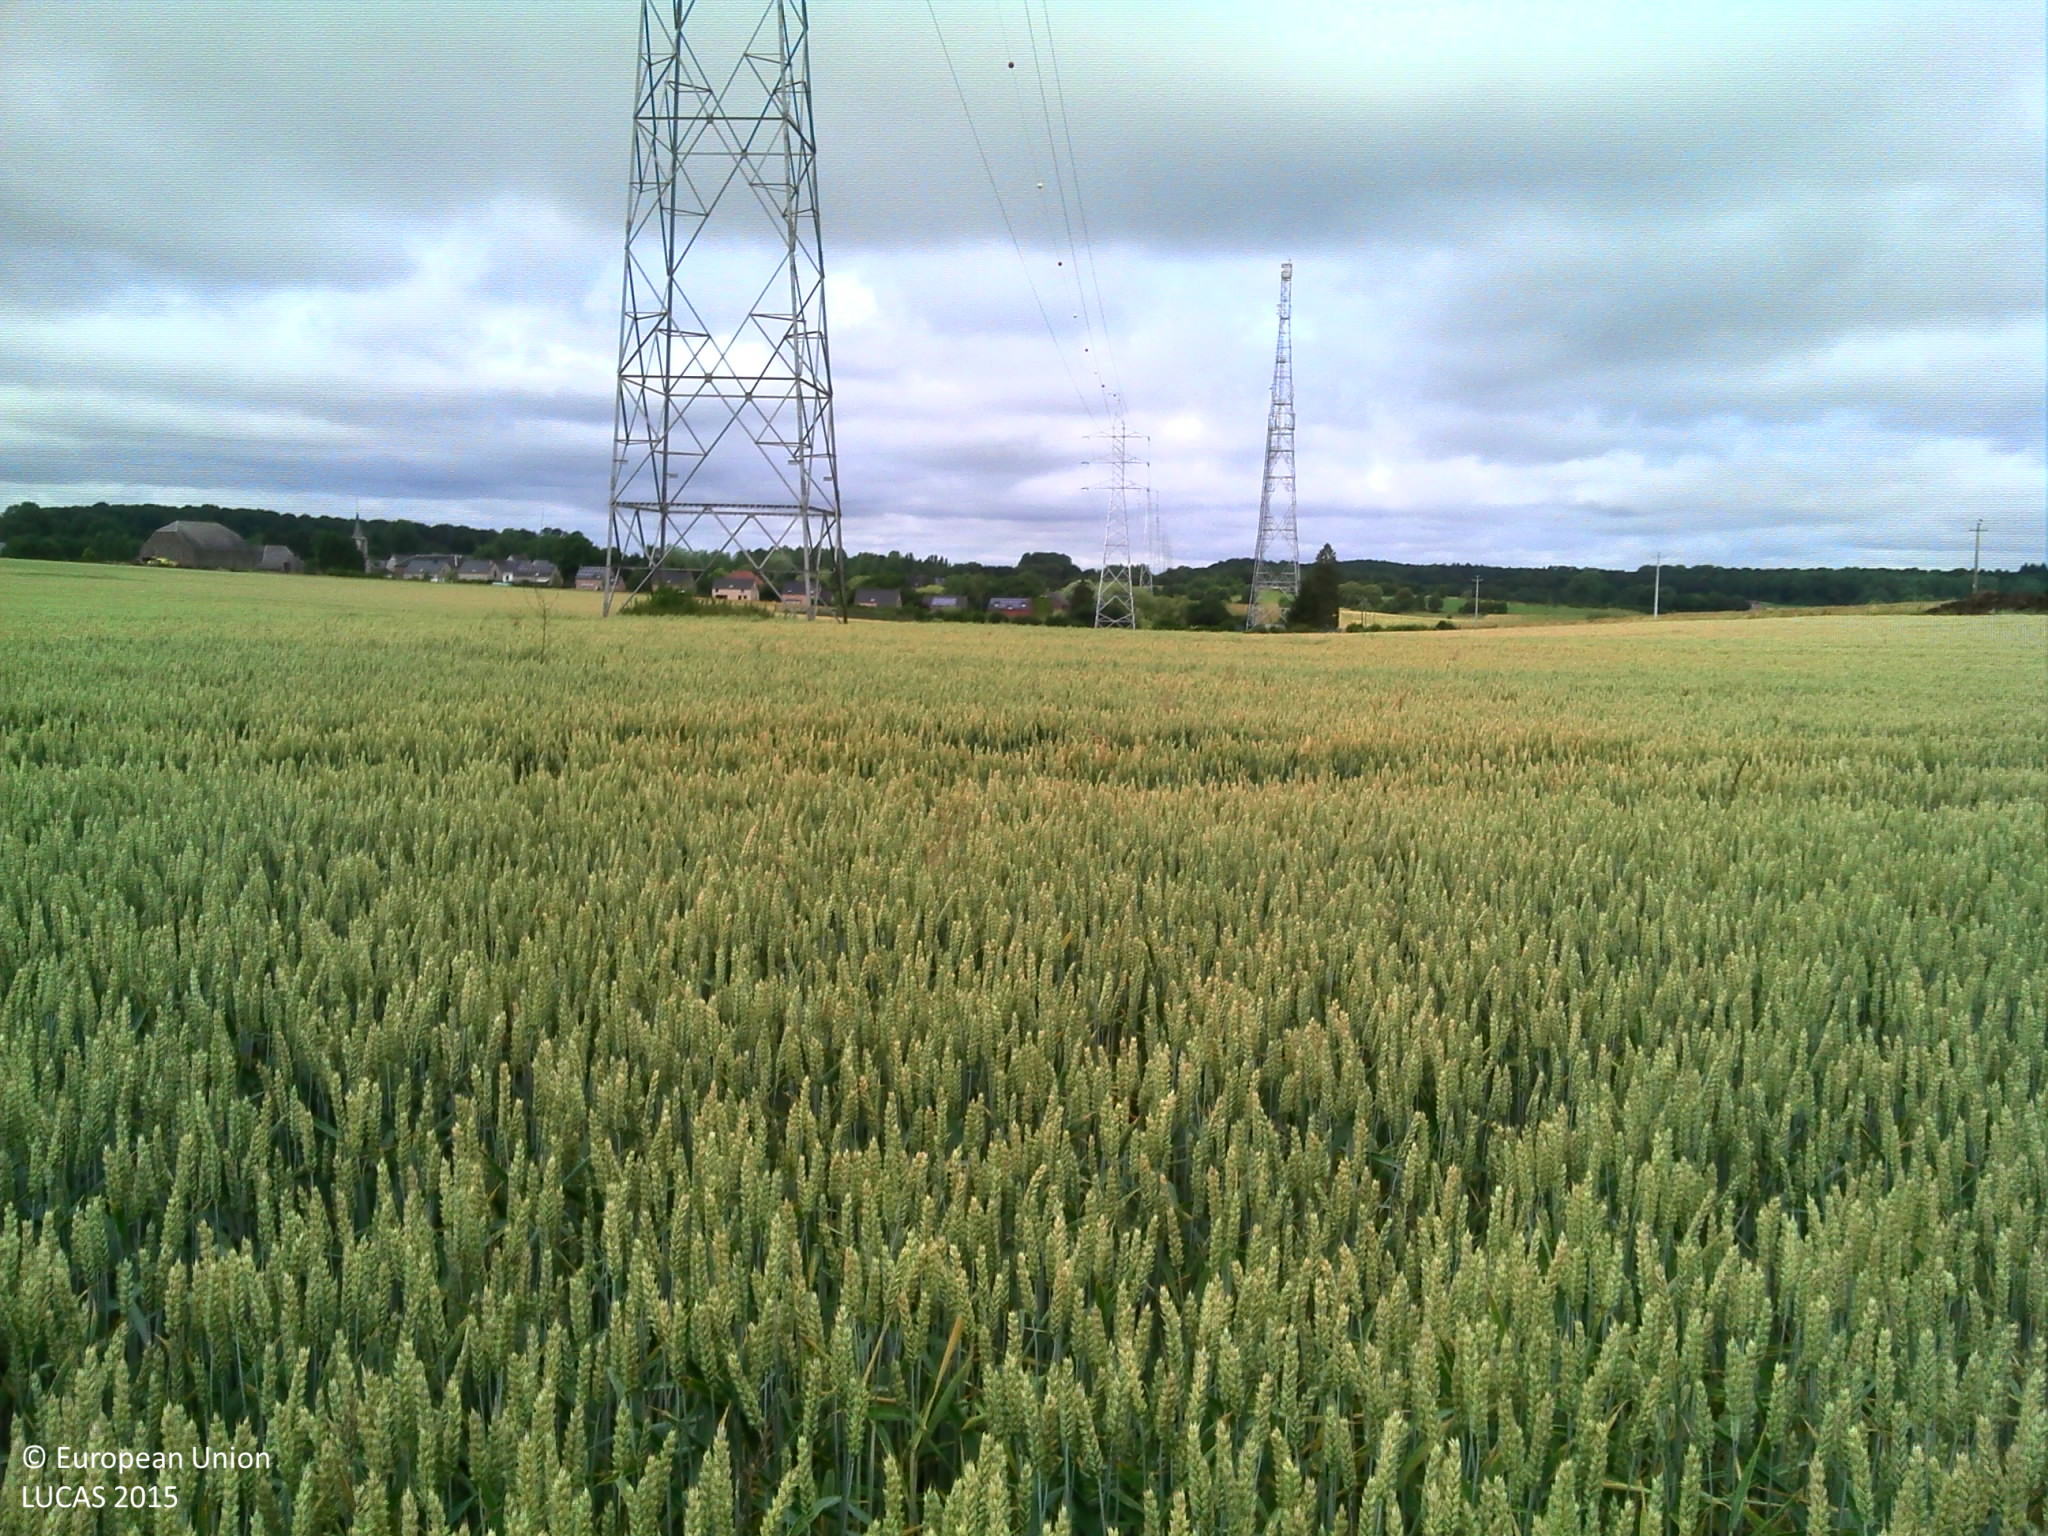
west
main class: Cropland
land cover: Common wheat
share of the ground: > 75 %
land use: Agriculture (excluding fallow land and kitchen gardens)
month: July
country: BE
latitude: 50.2146
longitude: 4.5166
